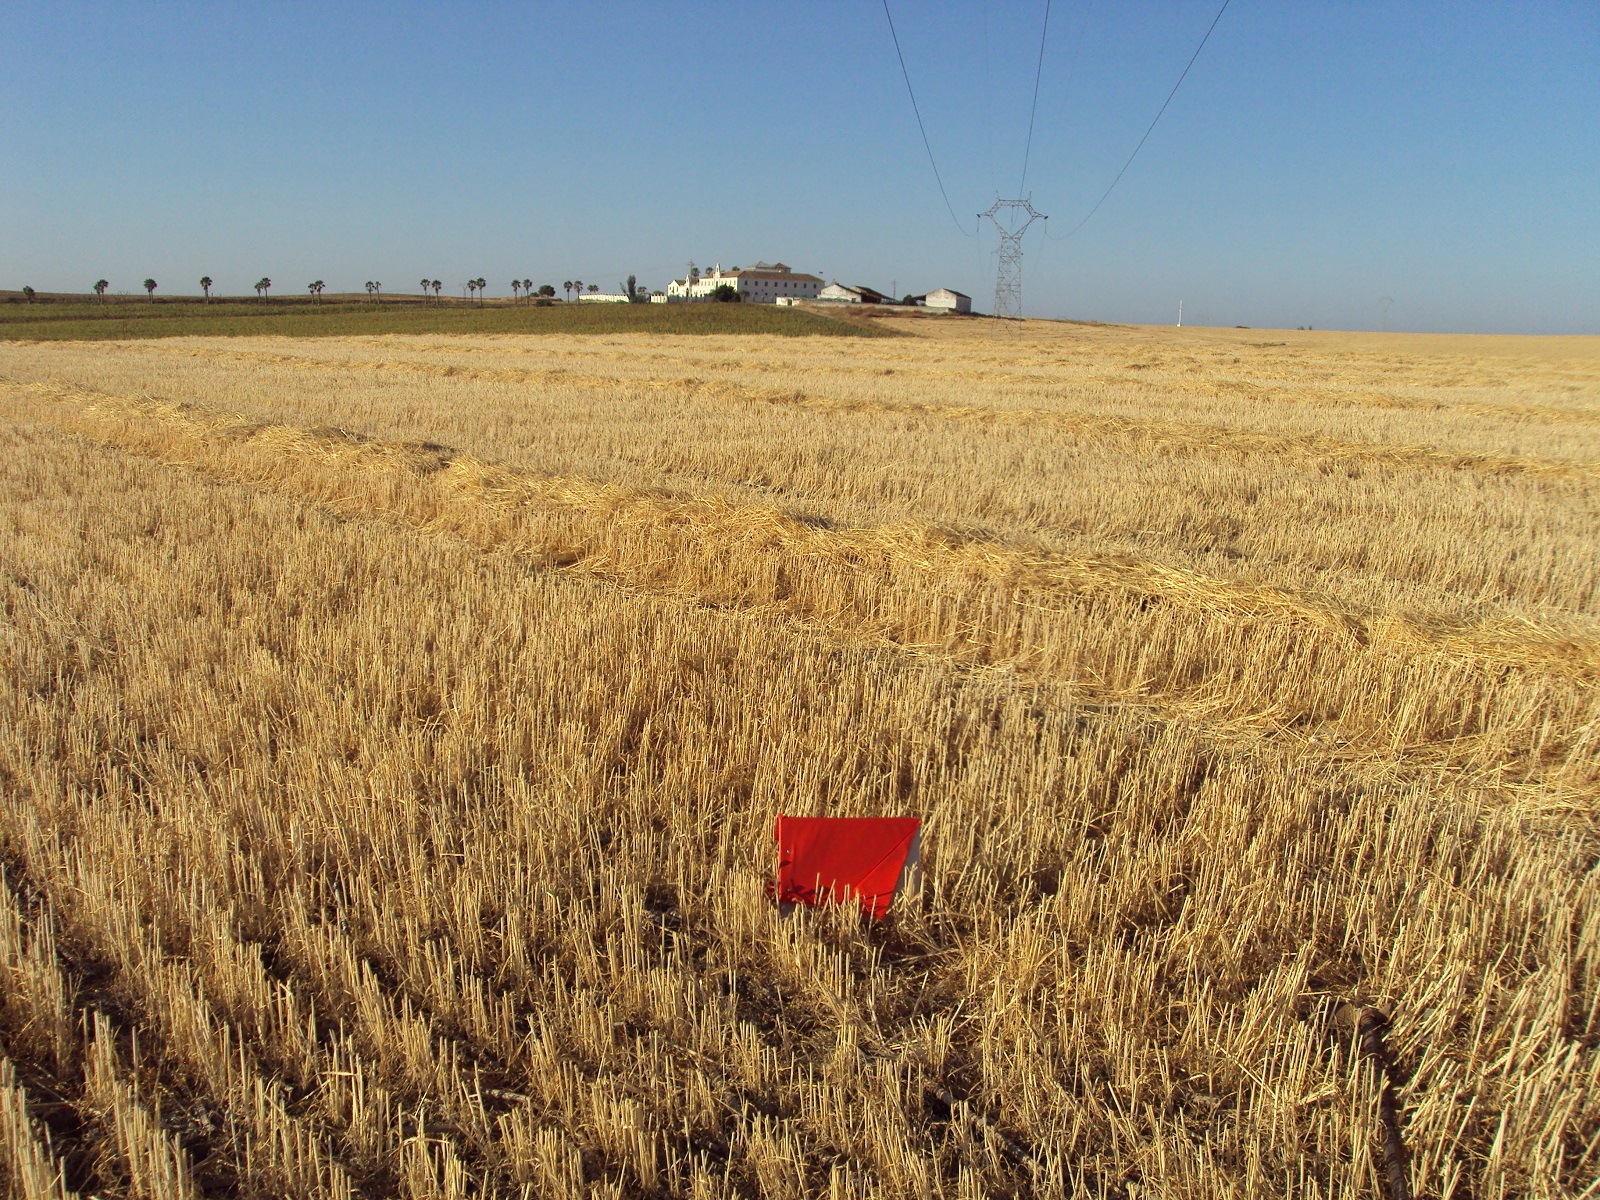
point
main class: Cropland
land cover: Durum wheat
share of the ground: > 75 %
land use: Agriculture (excluding fallow land and kitchen gardens)
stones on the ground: < 10 %
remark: Harvested field
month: June
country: ES
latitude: 37.2940
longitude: -6.9026
